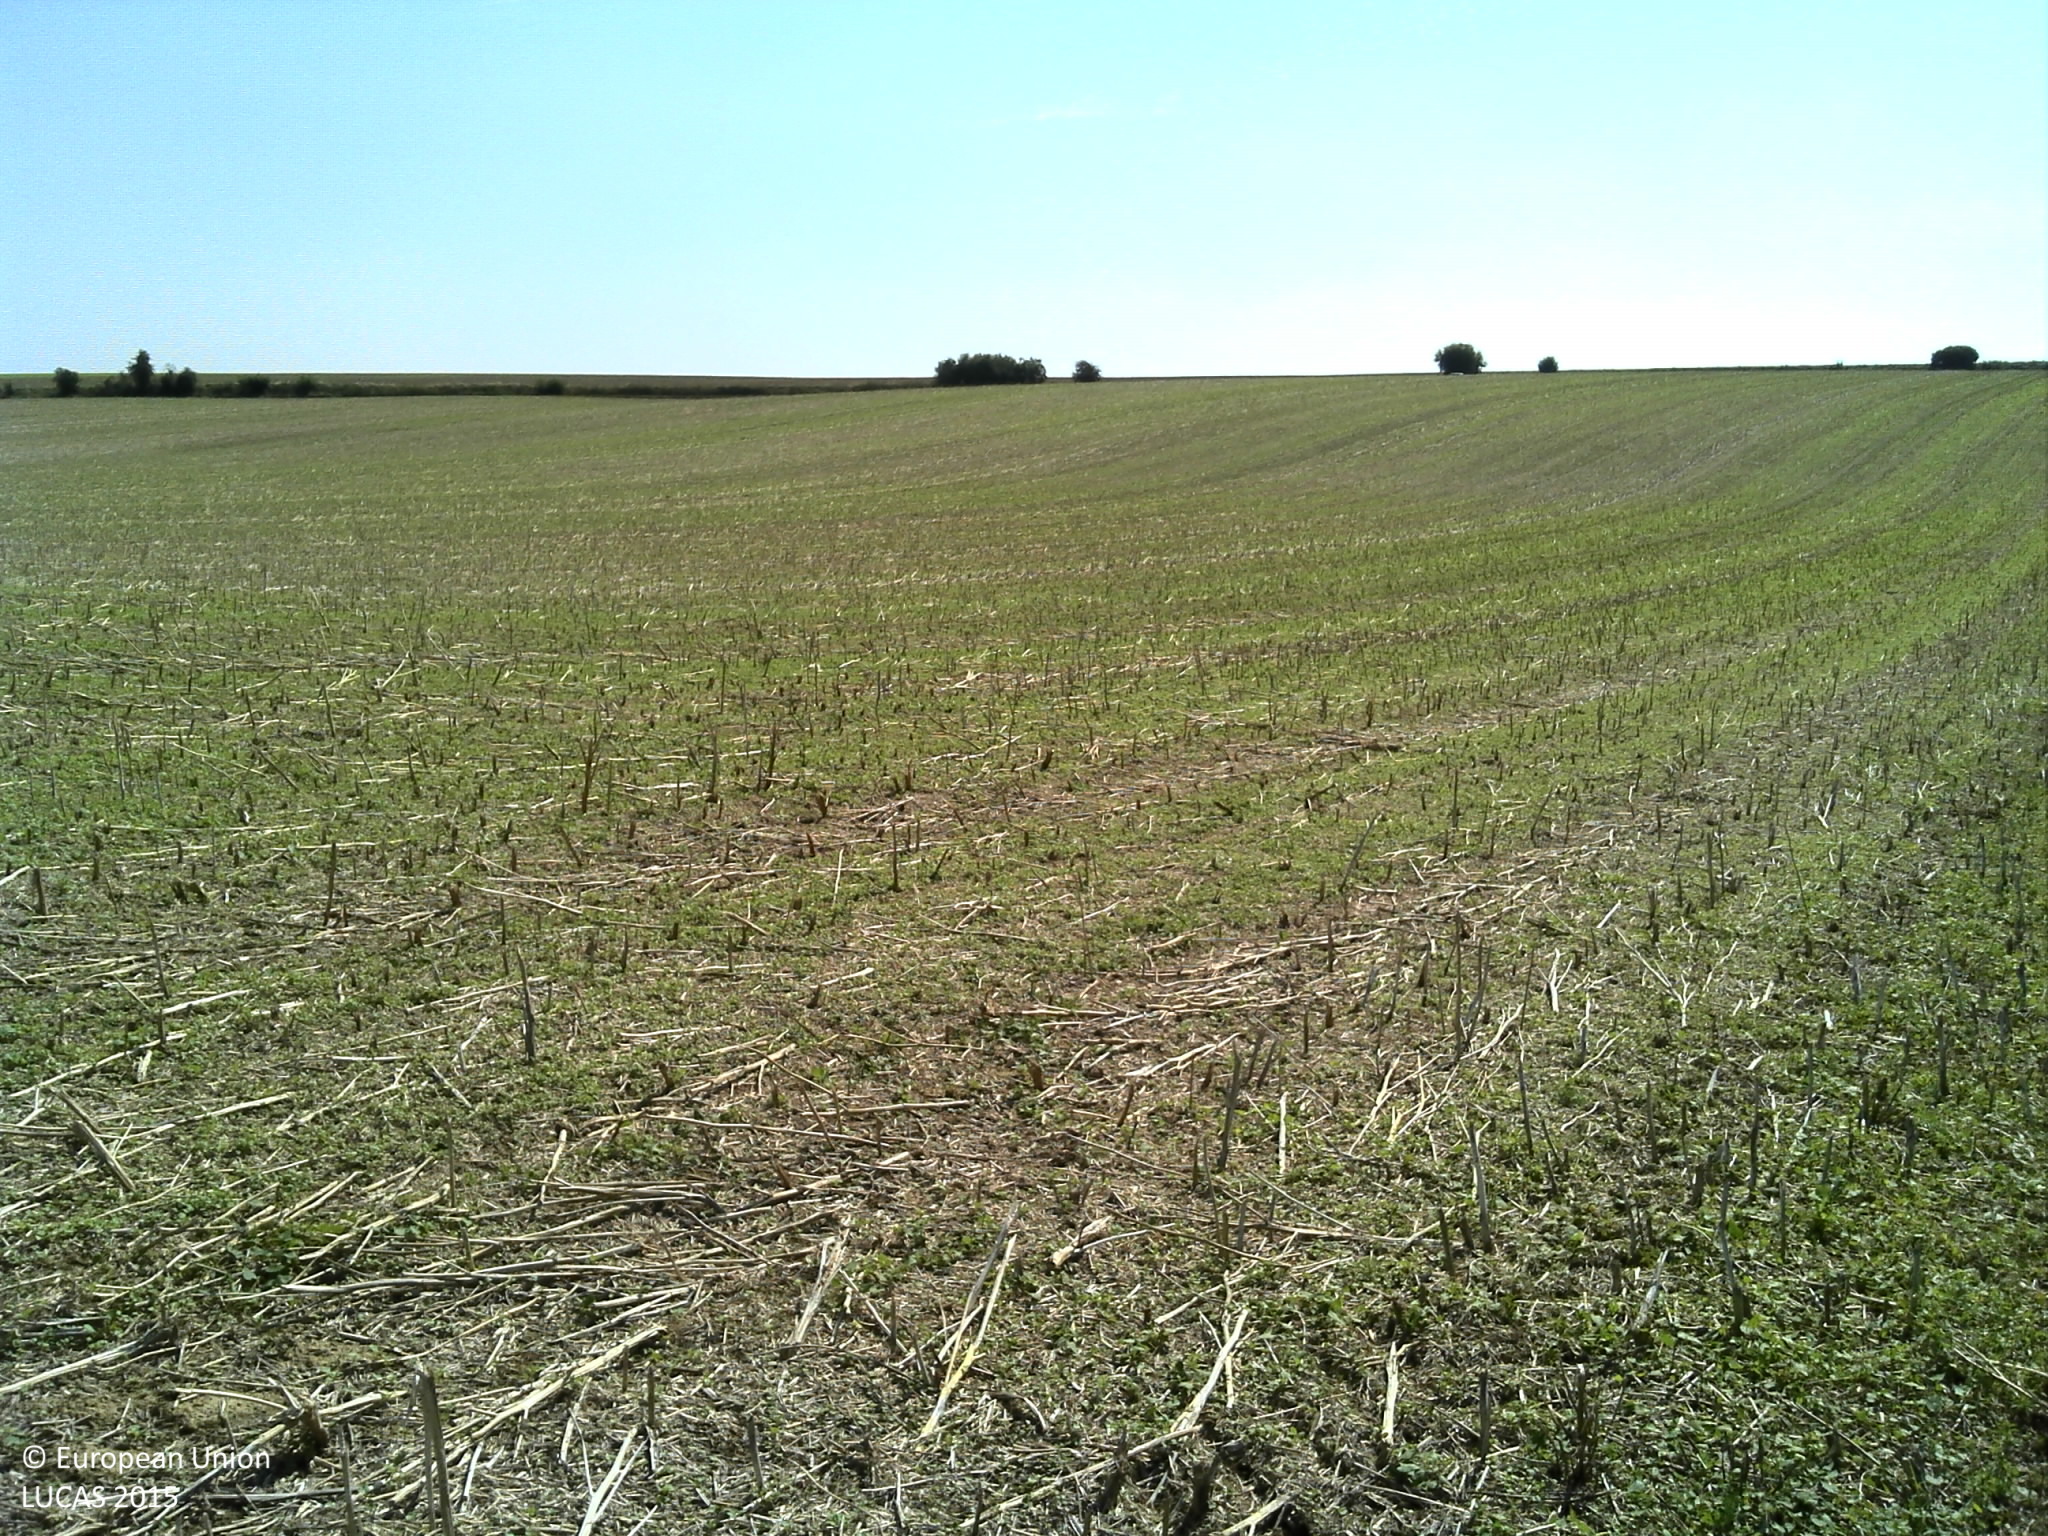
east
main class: Cropland
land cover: Rape and turnip rape
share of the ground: 10 - 25 %
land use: Agriculture (excluding fallow land and kitchen gardens)
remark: Harvested field
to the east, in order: Grass margins; Rape and turnip rape
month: August
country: FR
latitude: 50.0136
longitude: 3.1390
